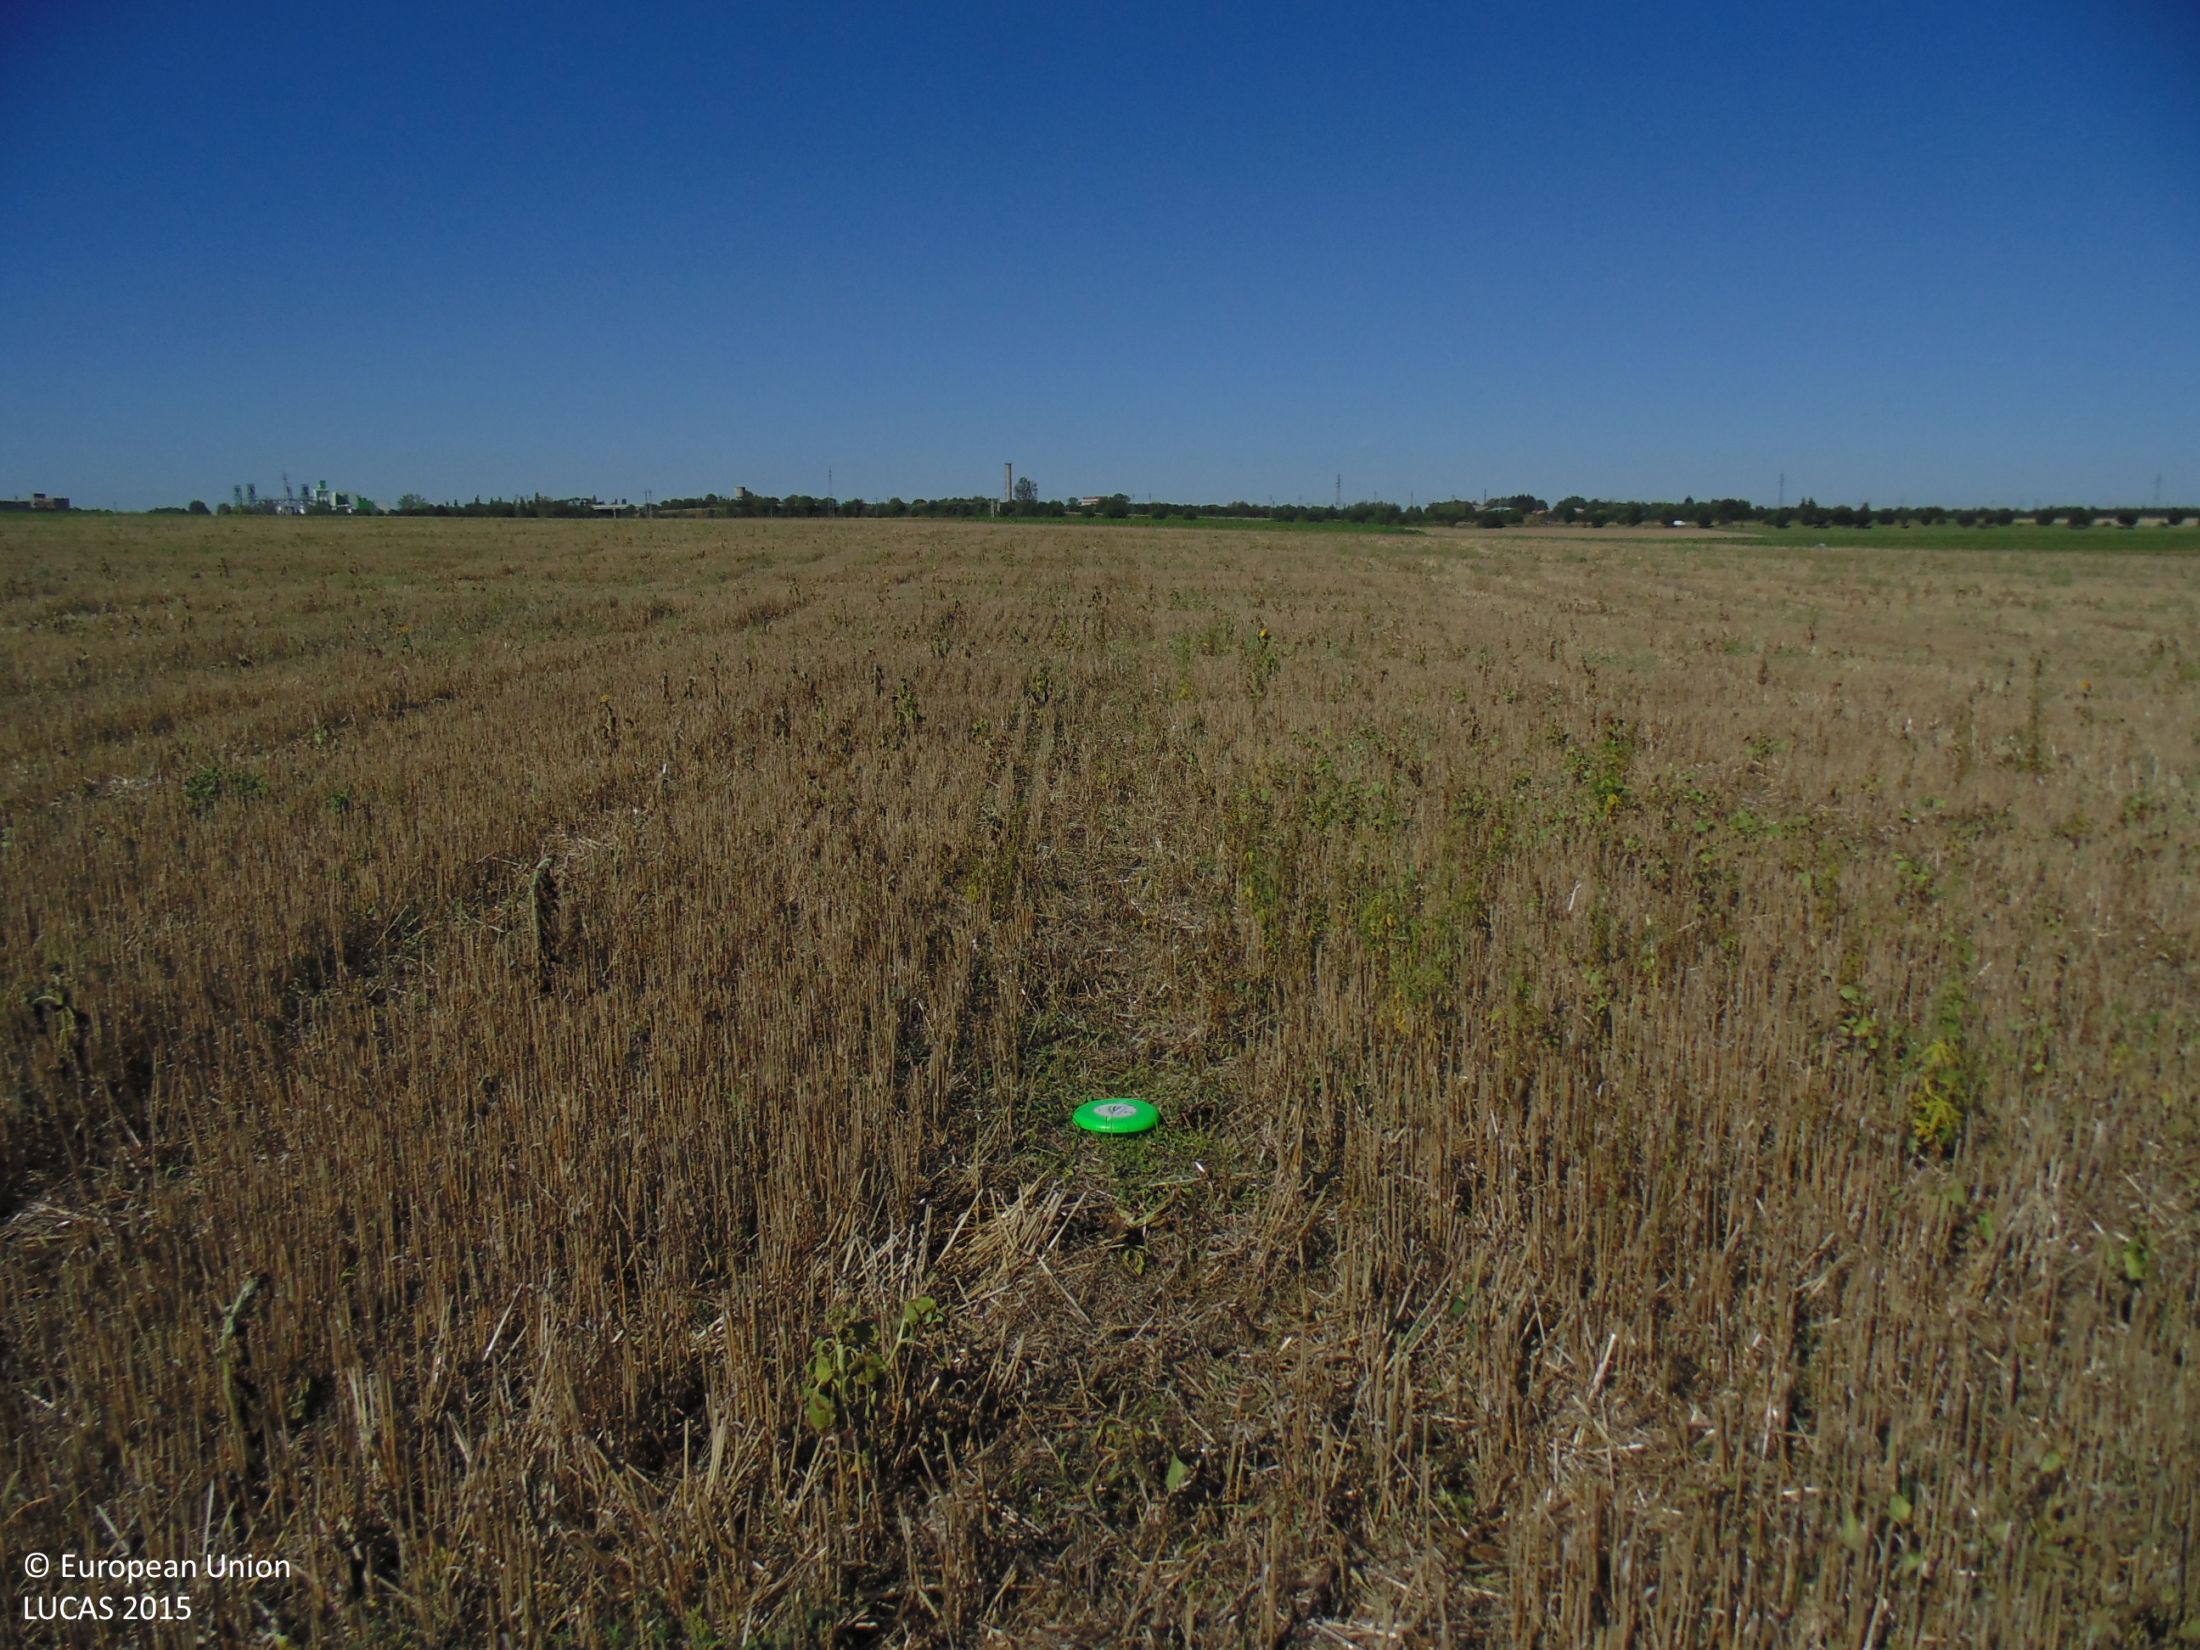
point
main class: Cropland
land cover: Common wheat
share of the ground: 50 - 75 %
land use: Agriculture (excluding fallow land and kitchen gardens)
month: September
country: BG
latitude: 43.8086
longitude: 27.1685
